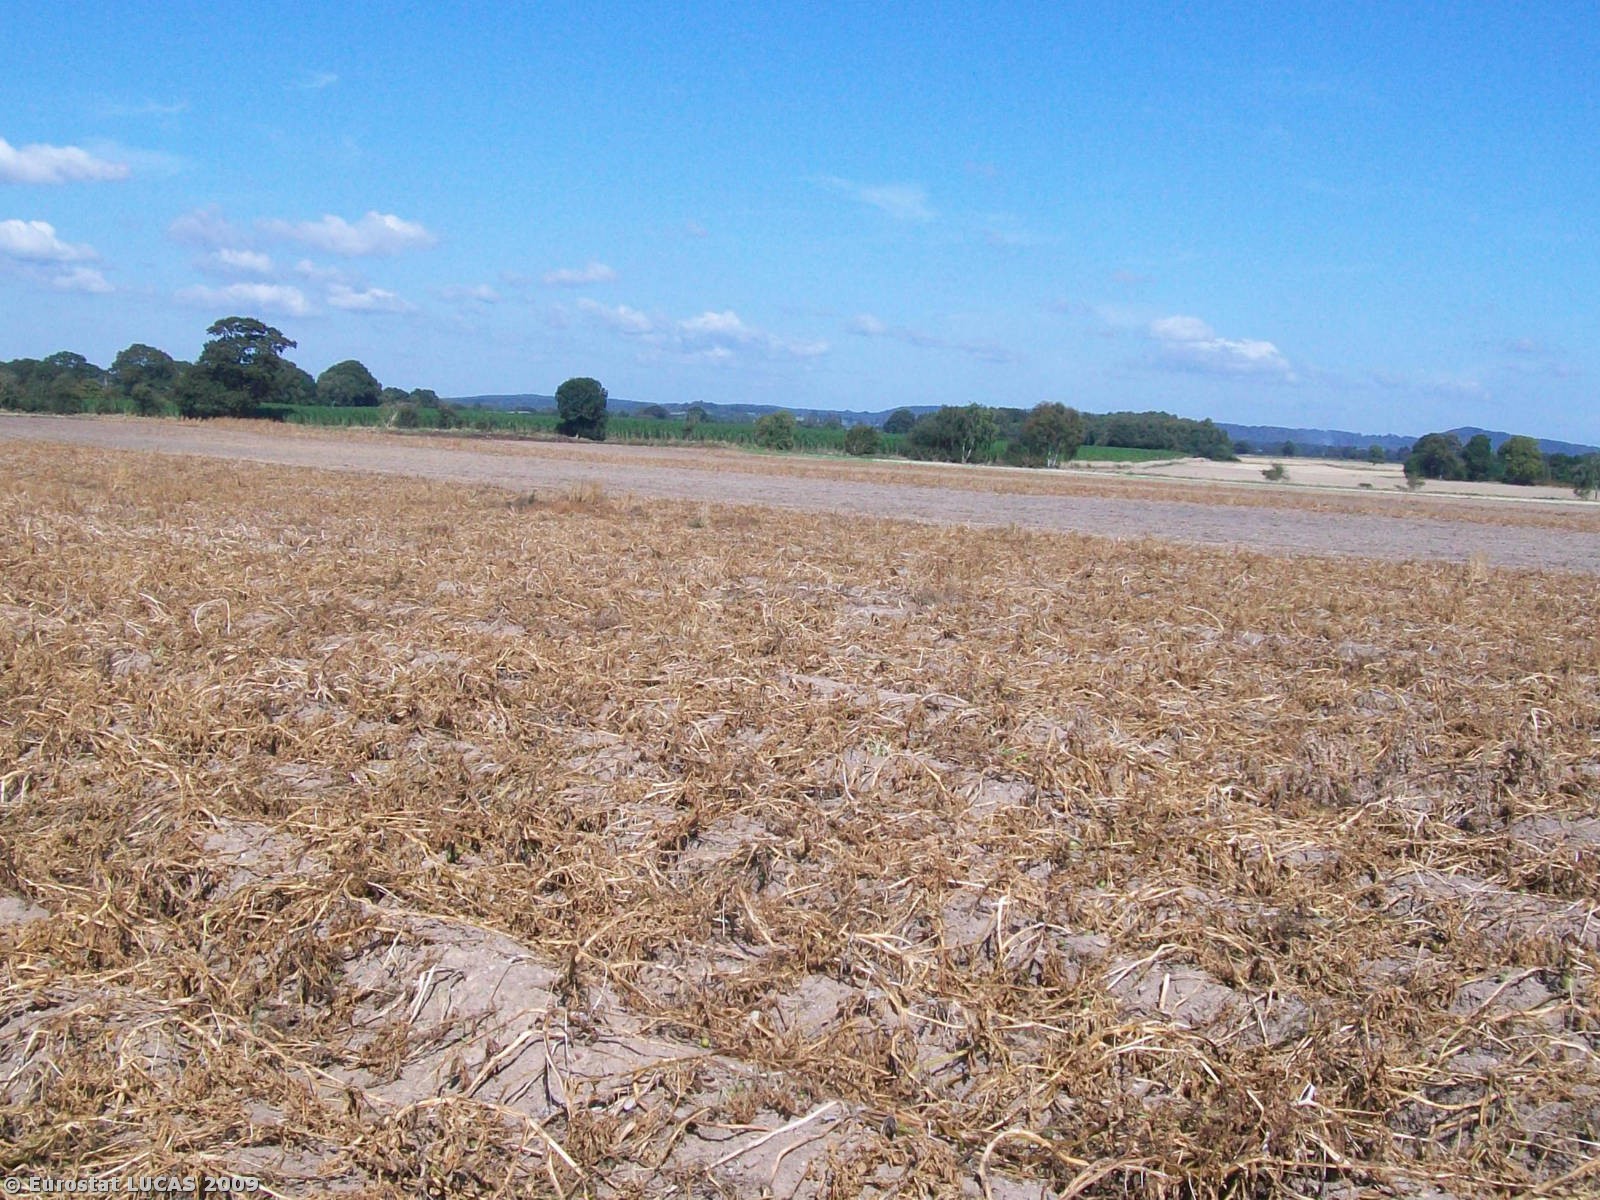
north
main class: Cropland
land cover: Potatoes
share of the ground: > 75 %
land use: Agriculture (excluding fallow land and kitchen gardens)
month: September
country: GB
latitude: 52.7744
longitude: -2.6236
